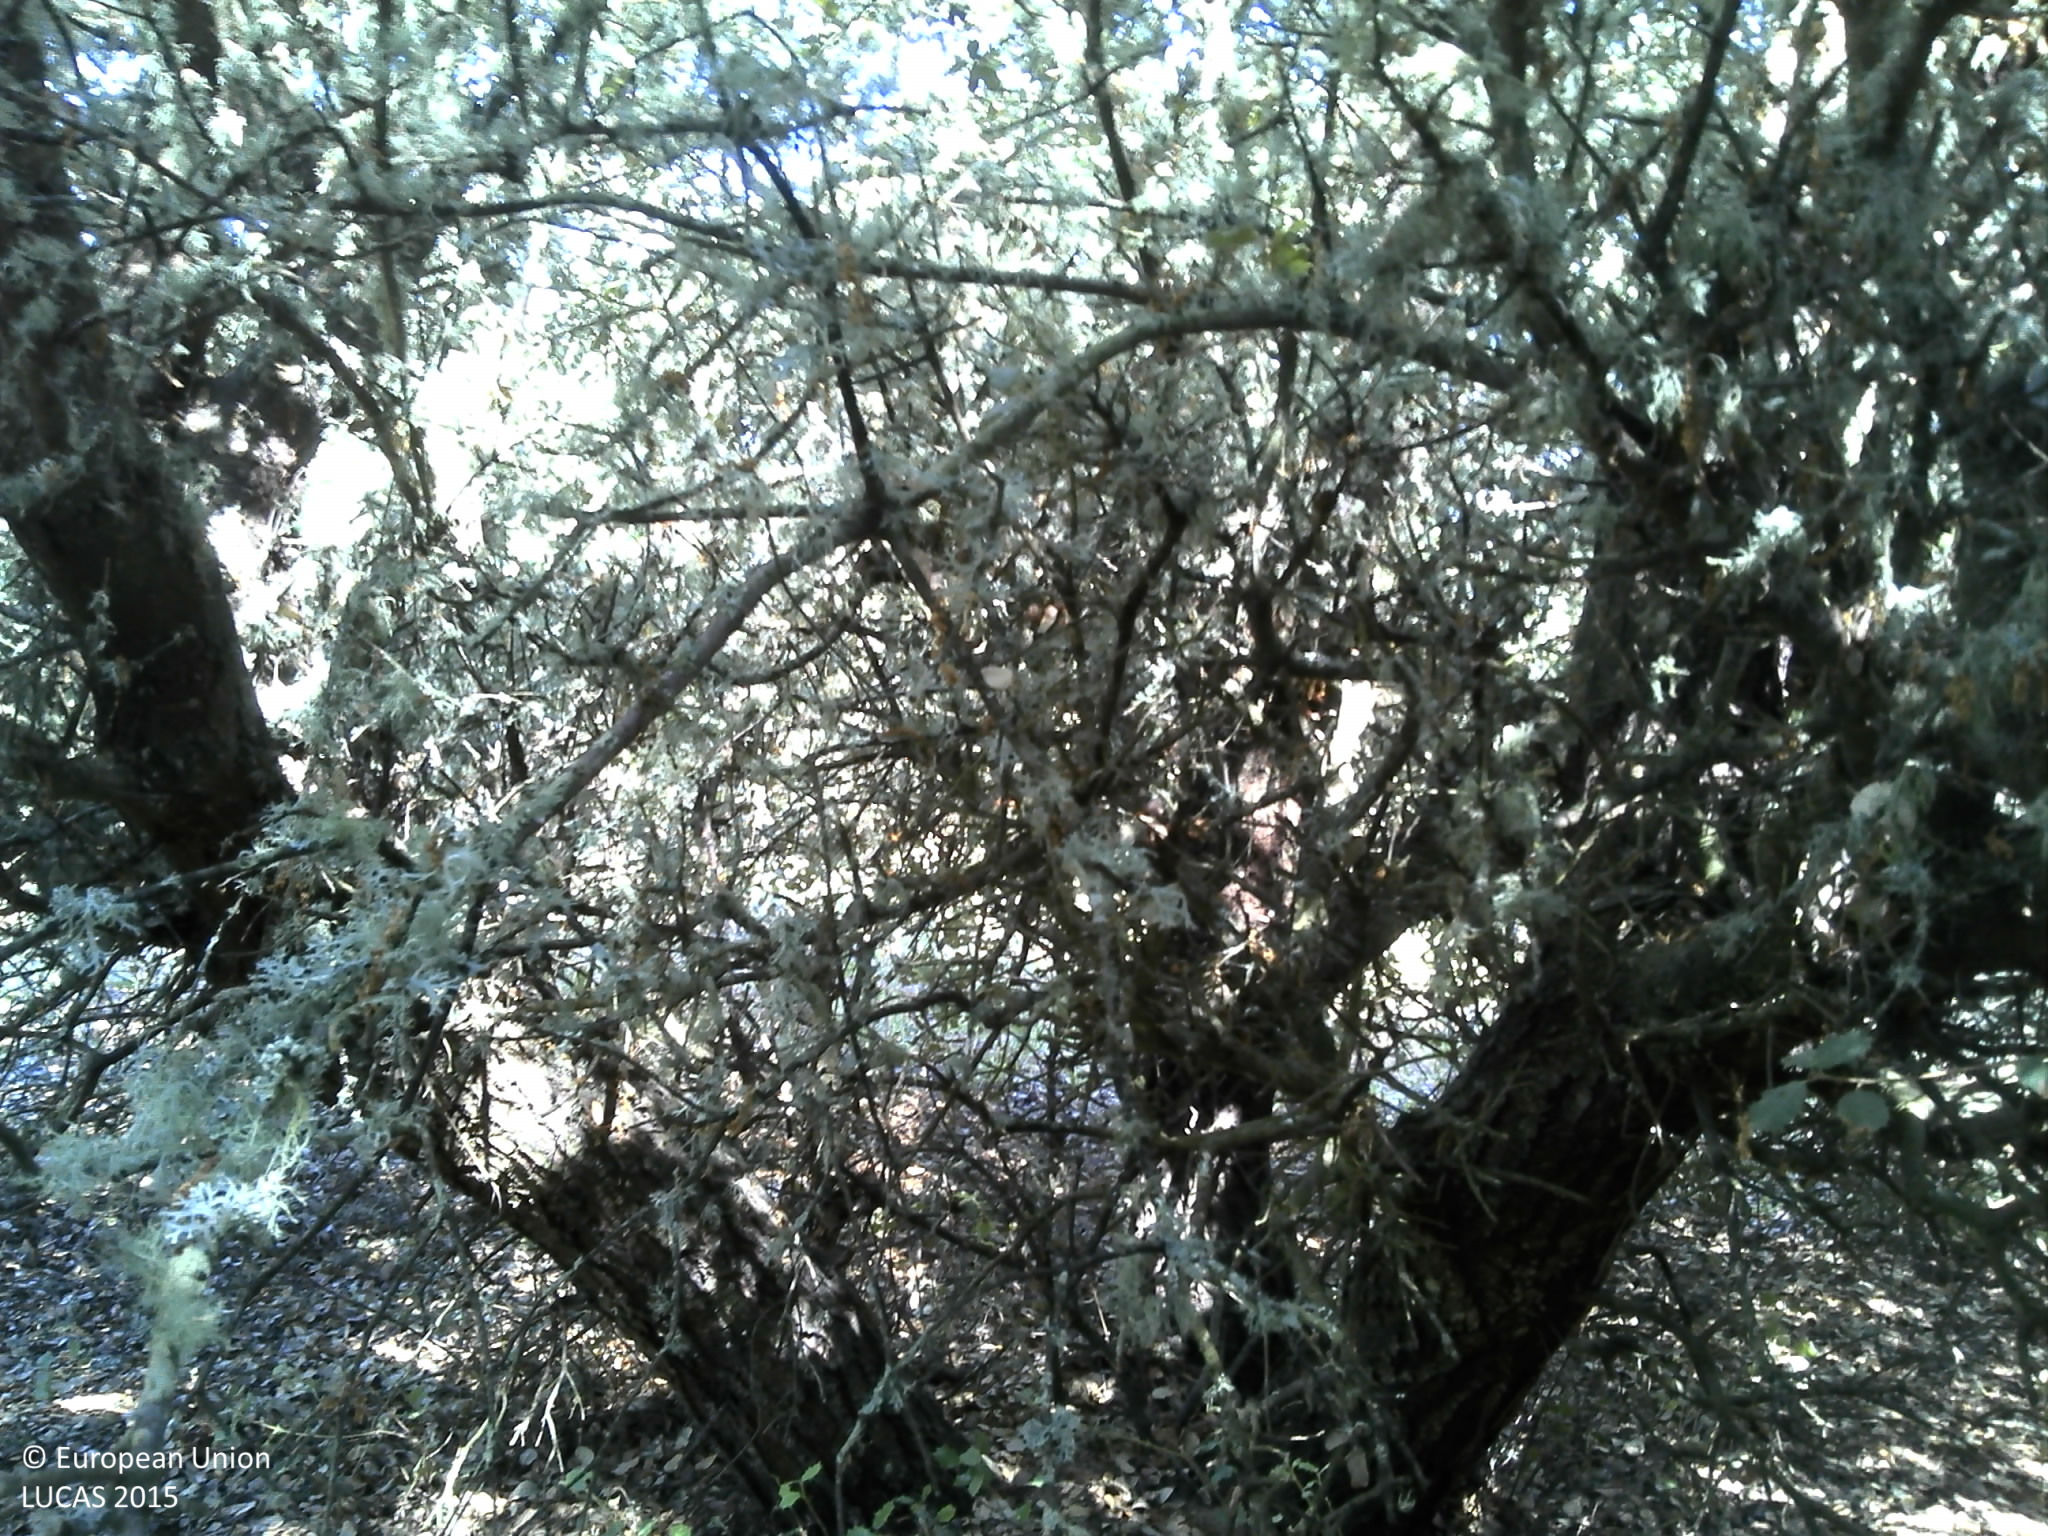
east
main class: Woodland
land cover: Broadleaved woodland
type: broadleaved evergreen forest
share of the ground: 25 - 50 %
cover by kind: shrubs 40 %, herbaceous plants 30 %, broadleaved forest trees 25 %, unconsolidated bare surface 5 %
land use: Forestry
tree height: > 5 m
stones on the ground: < 10 %
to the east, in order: Broadleaved woodland; Inland fresh water bodies
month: June
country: PT
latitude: 40.8556
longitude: -6.8875
